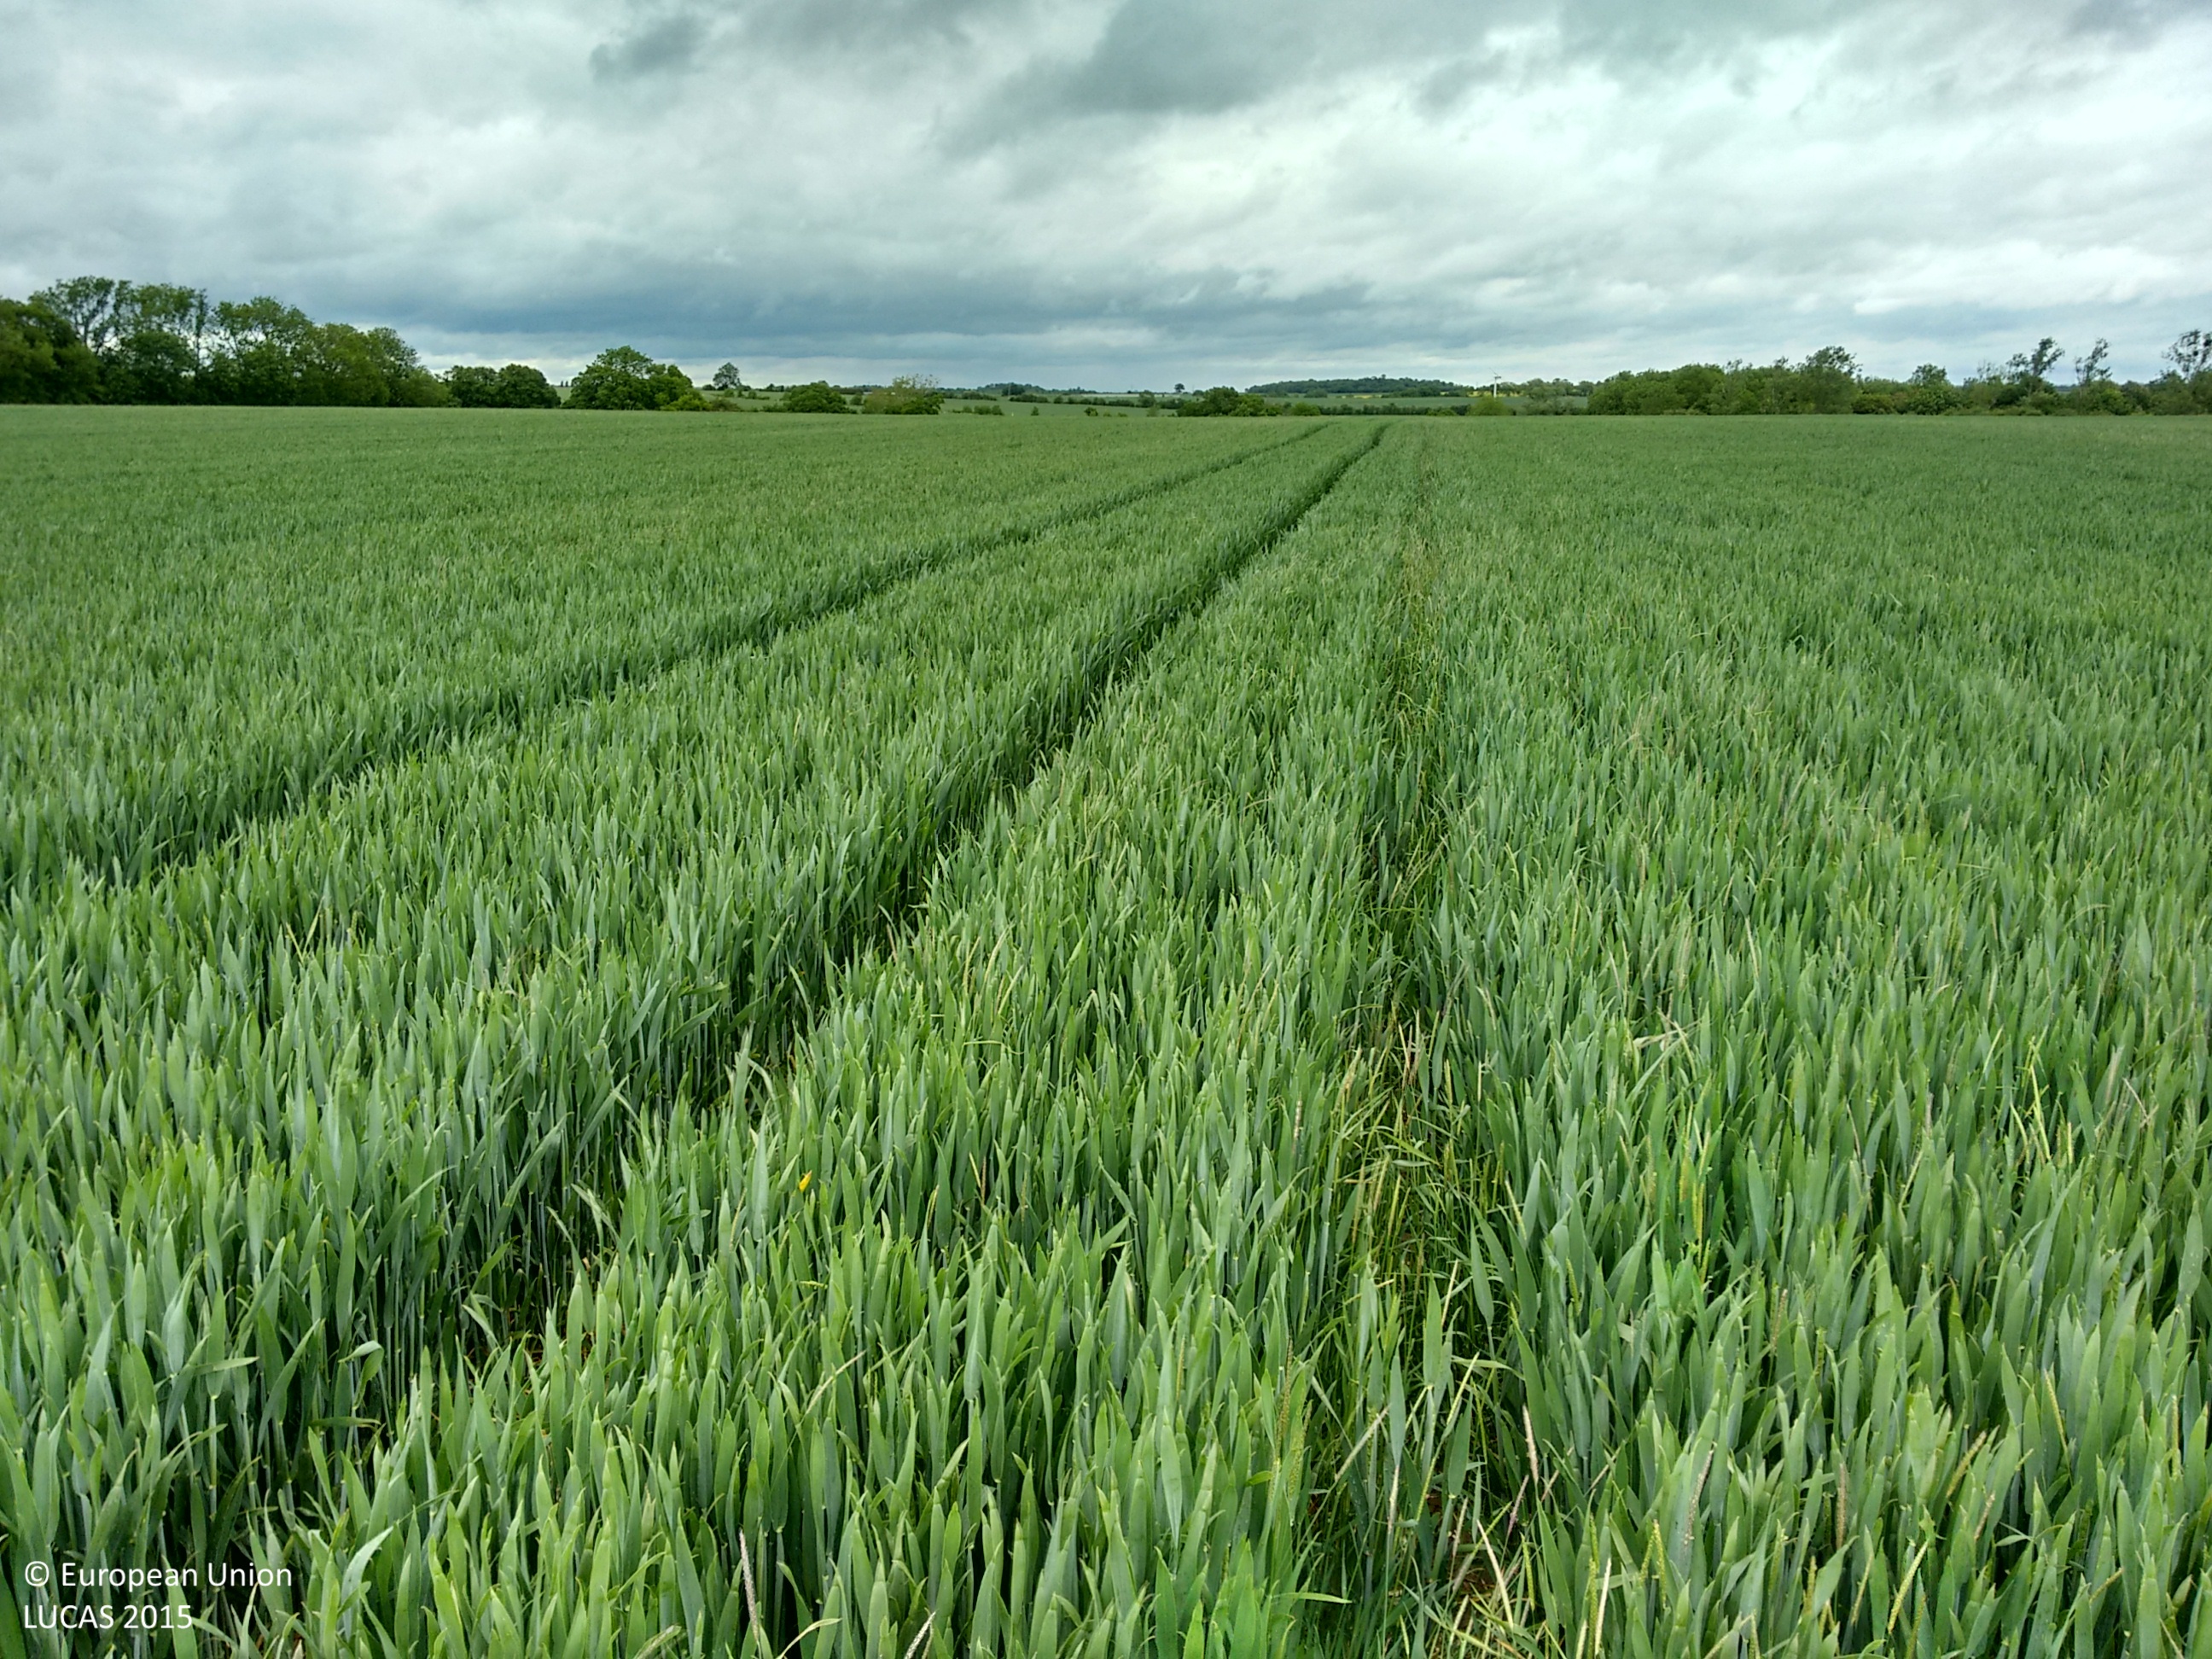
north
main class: Cropland
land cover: Common wheat
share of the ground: > 75 %
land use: Agriculture (excluding fallow land and kitchen gardens)
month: May
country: GB
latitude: 52.1576
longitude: -0.3712
